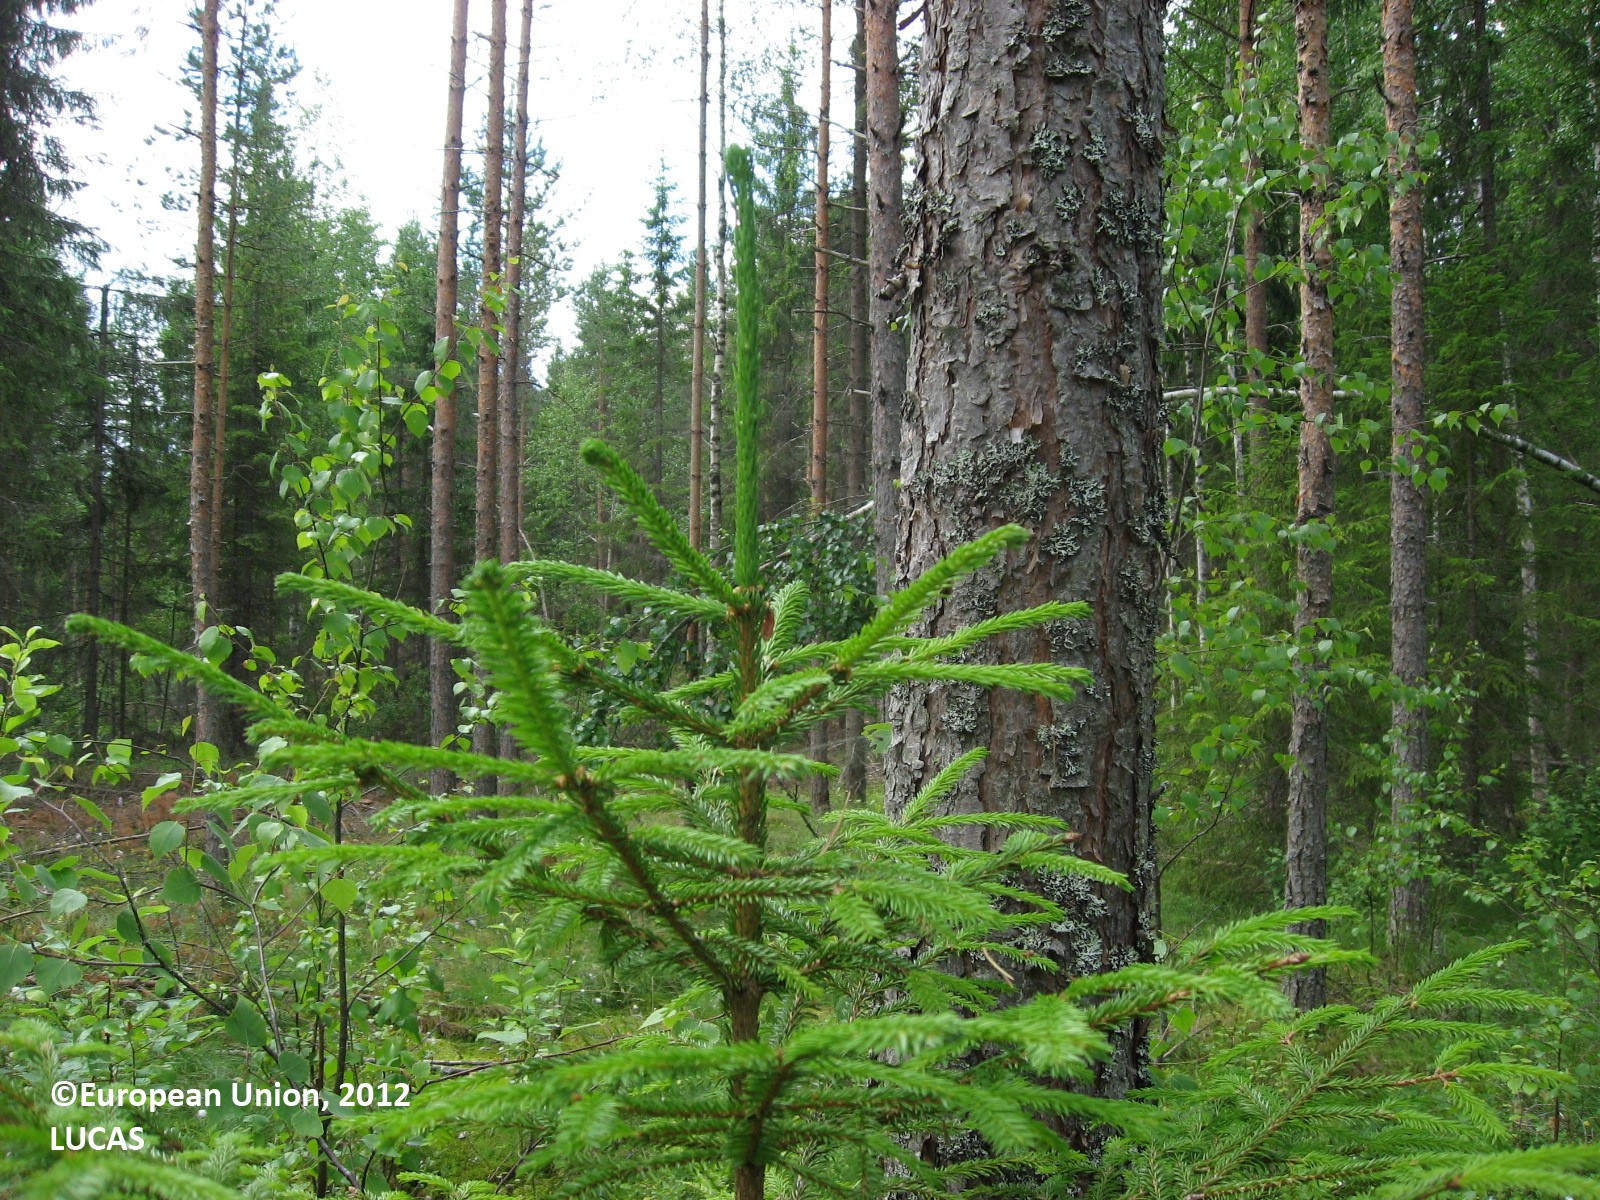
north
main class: Woodland
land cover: Other mixed woodland
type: mire and swamp forests
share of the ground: 25 - 50 %
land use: Forestry
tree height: > 5 m
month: July
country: FI
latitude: 60.8927
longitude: 26.5370
